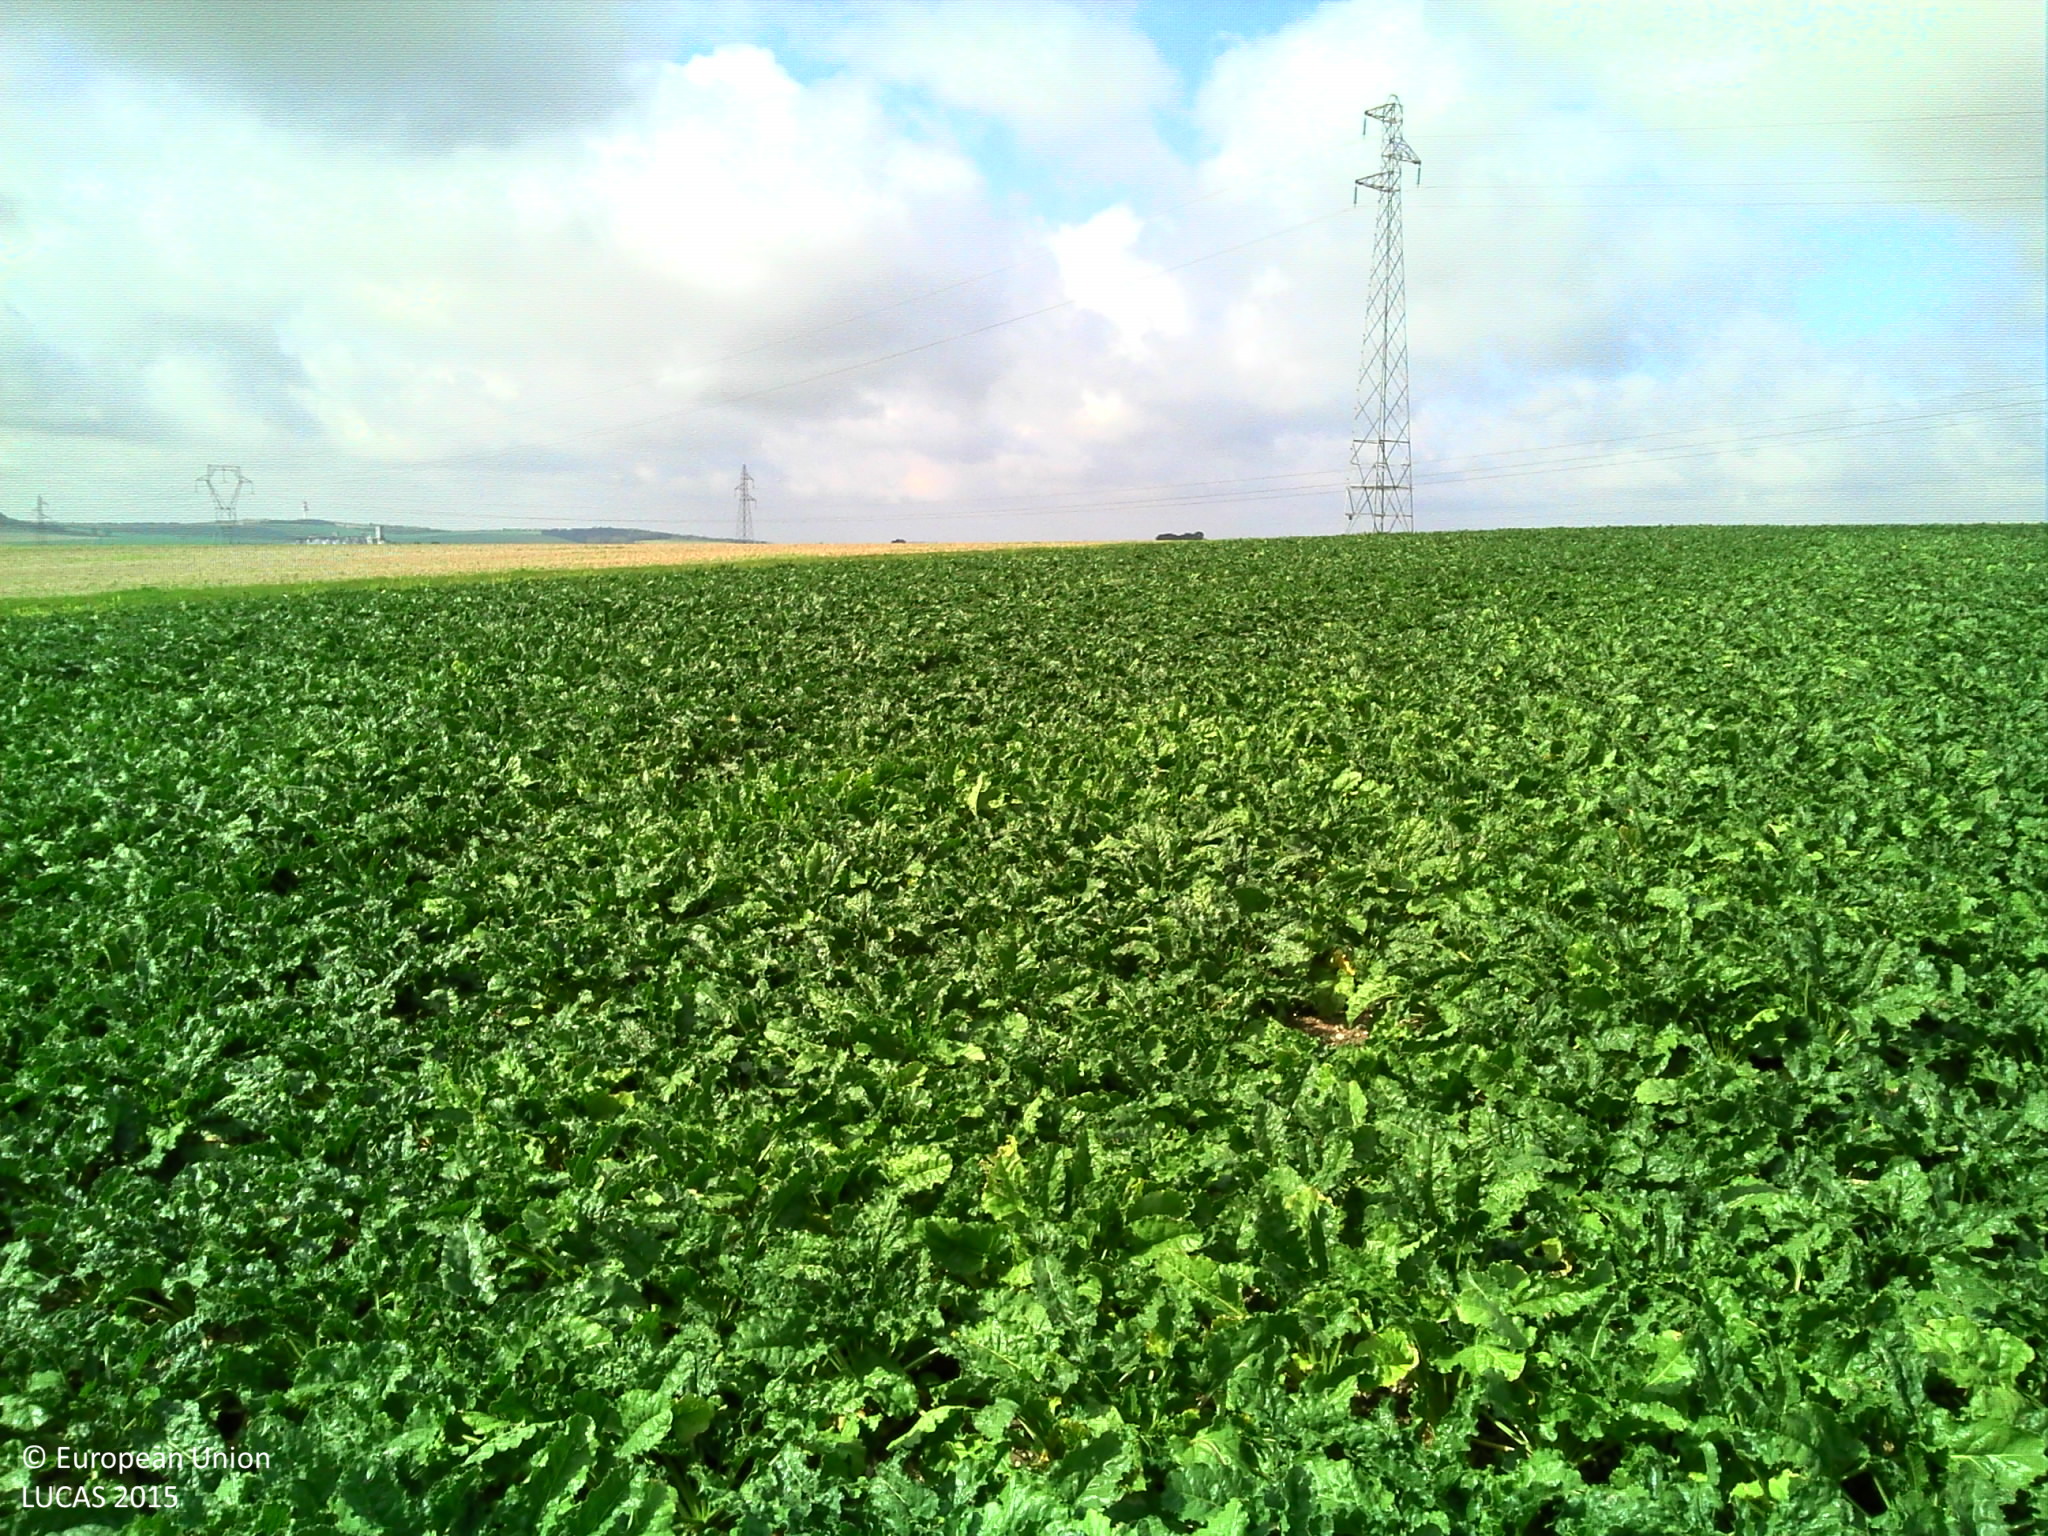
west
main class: Cropland
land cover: Sugar beet
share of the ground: > 75 %
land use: Agriculture (excluding fallow land and kitchen gardens)
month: September
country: FR
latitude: 48.3792
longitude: 4.2315
